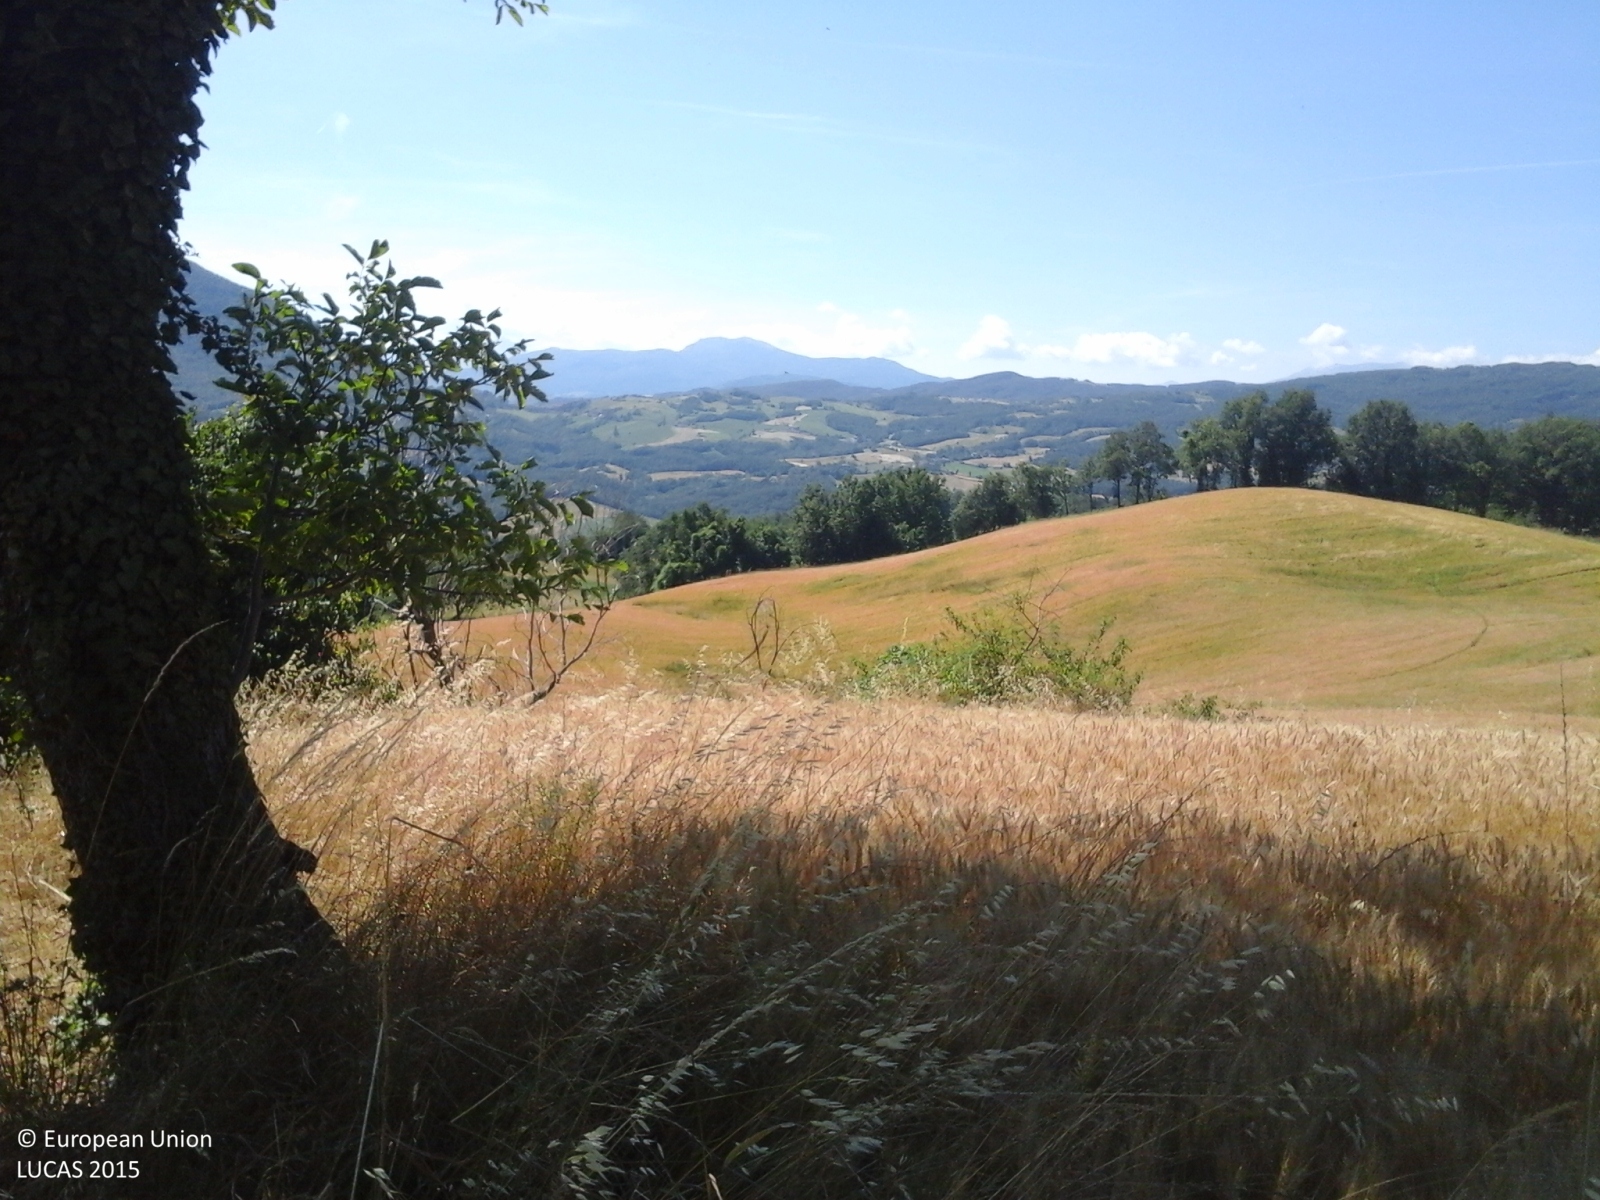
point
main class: Cropland
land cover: Common wheat
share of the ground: > 75 %
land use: Agriculture (excluding fallow land and kitchen gardens)
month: June
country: IT
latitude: 44.5307
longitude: 10.2134
